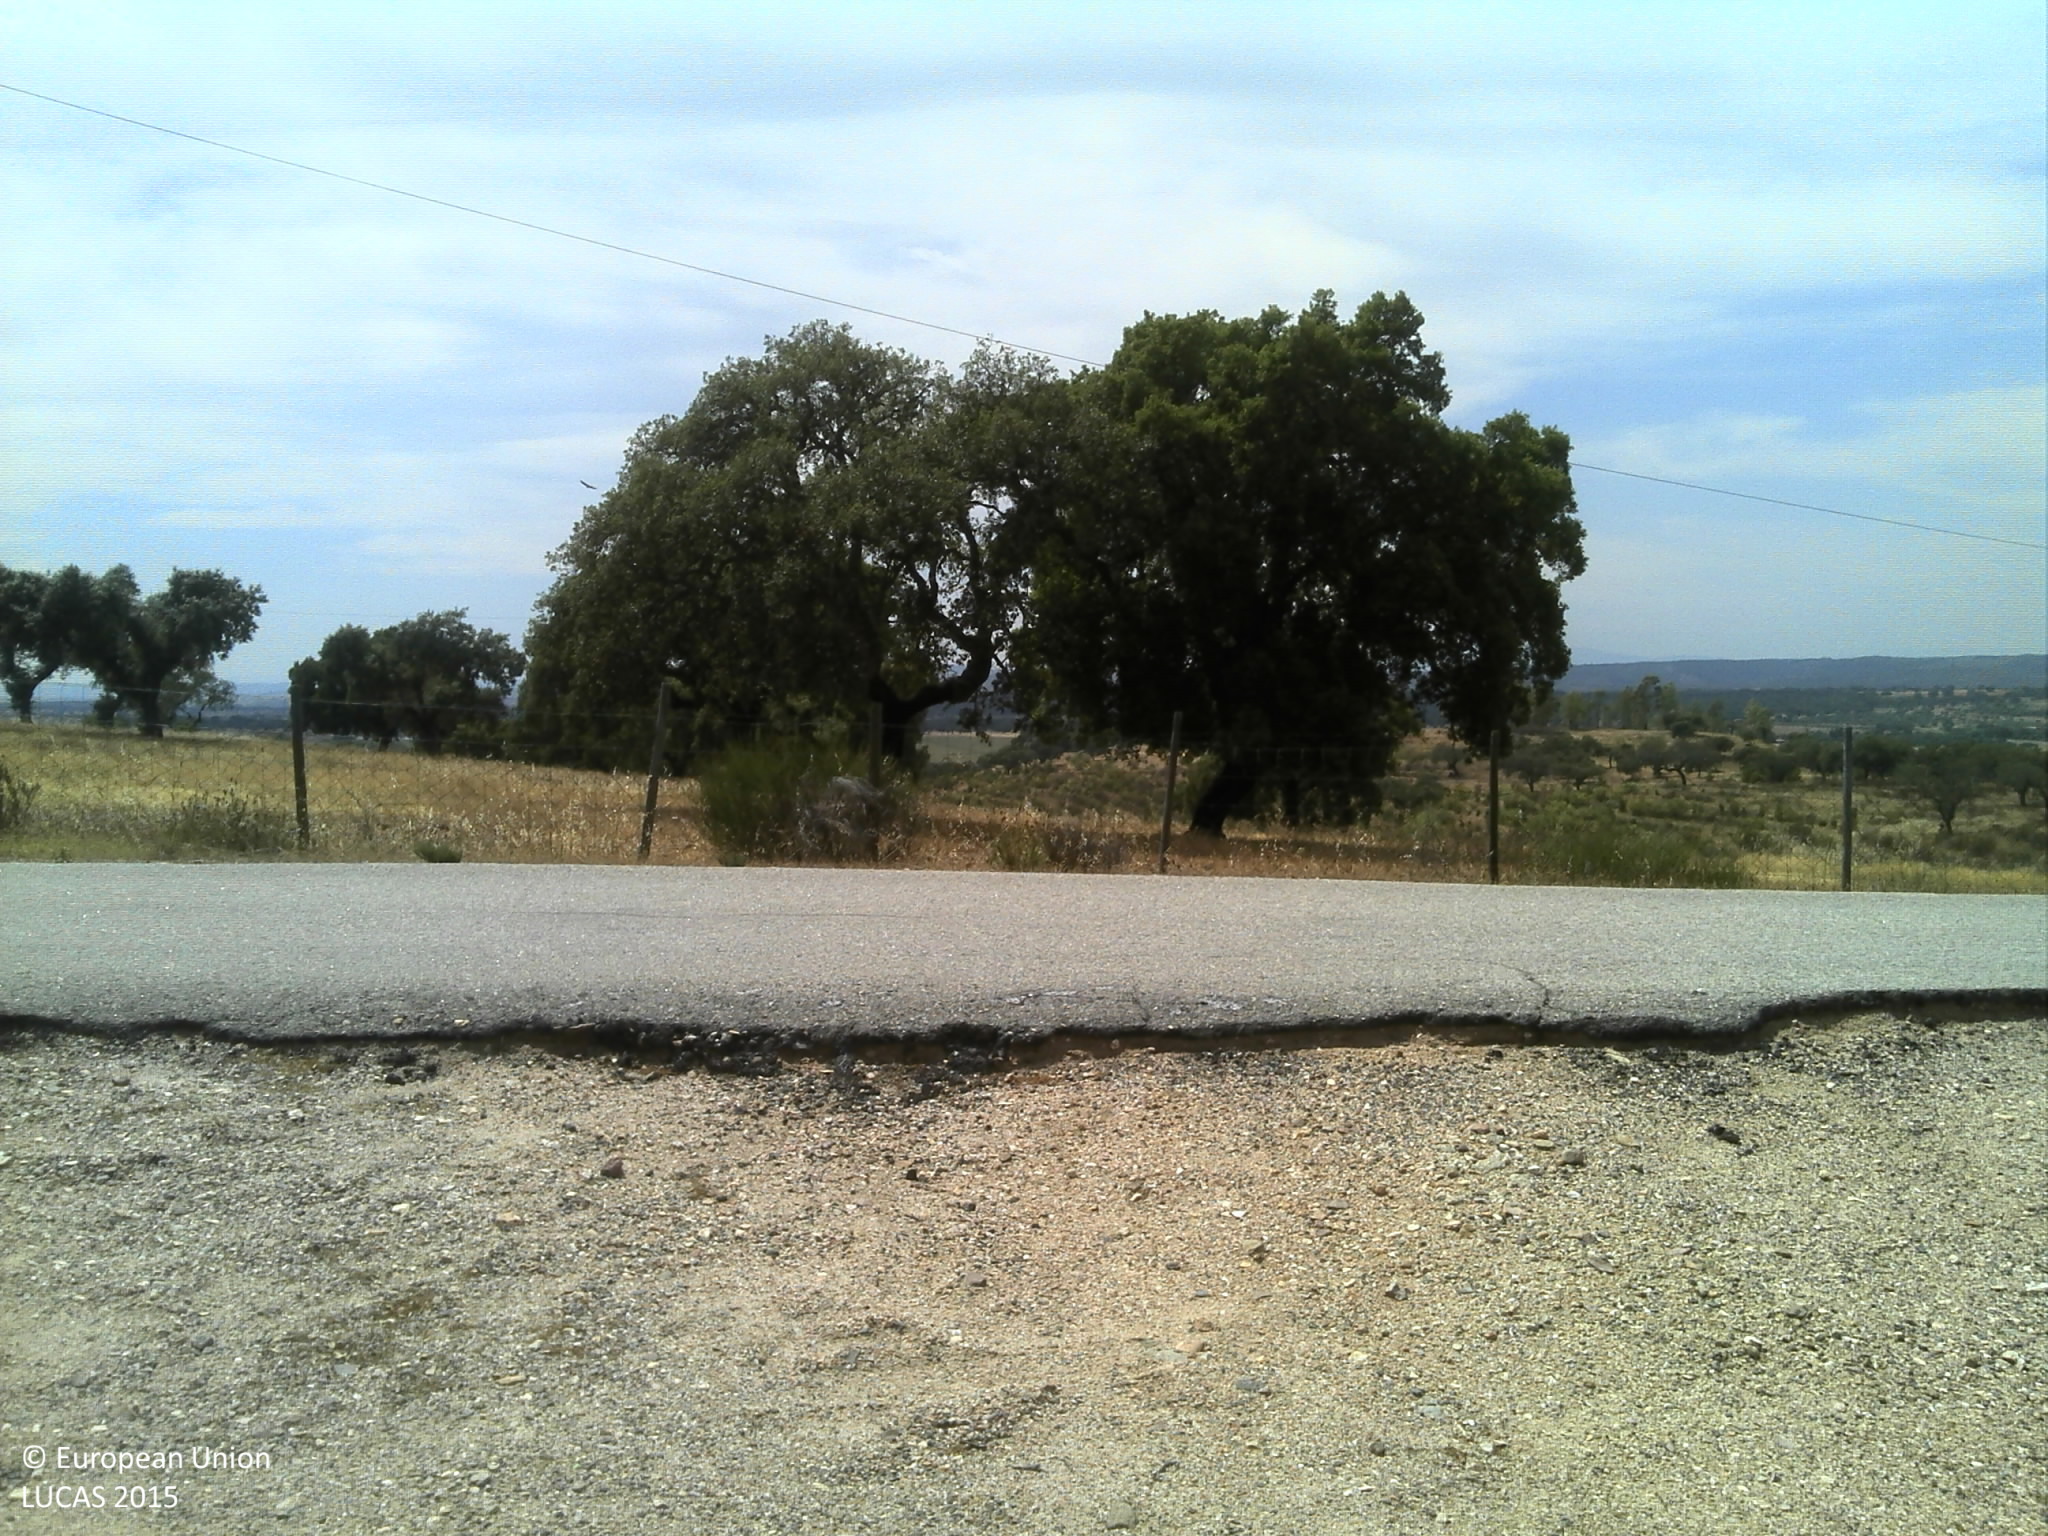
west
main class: Woodland
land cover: Broadleaved woodland
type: broadleaved evergreen forest
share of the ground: 25 - 50 %
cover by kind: broadleaved forest trees 40 %, herbaceous plants 40 %, unconsolidated bare surface 20 %
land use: Forestry
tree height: > 5 m
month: June
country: PT
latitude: 39.8941
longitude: -7.0119
